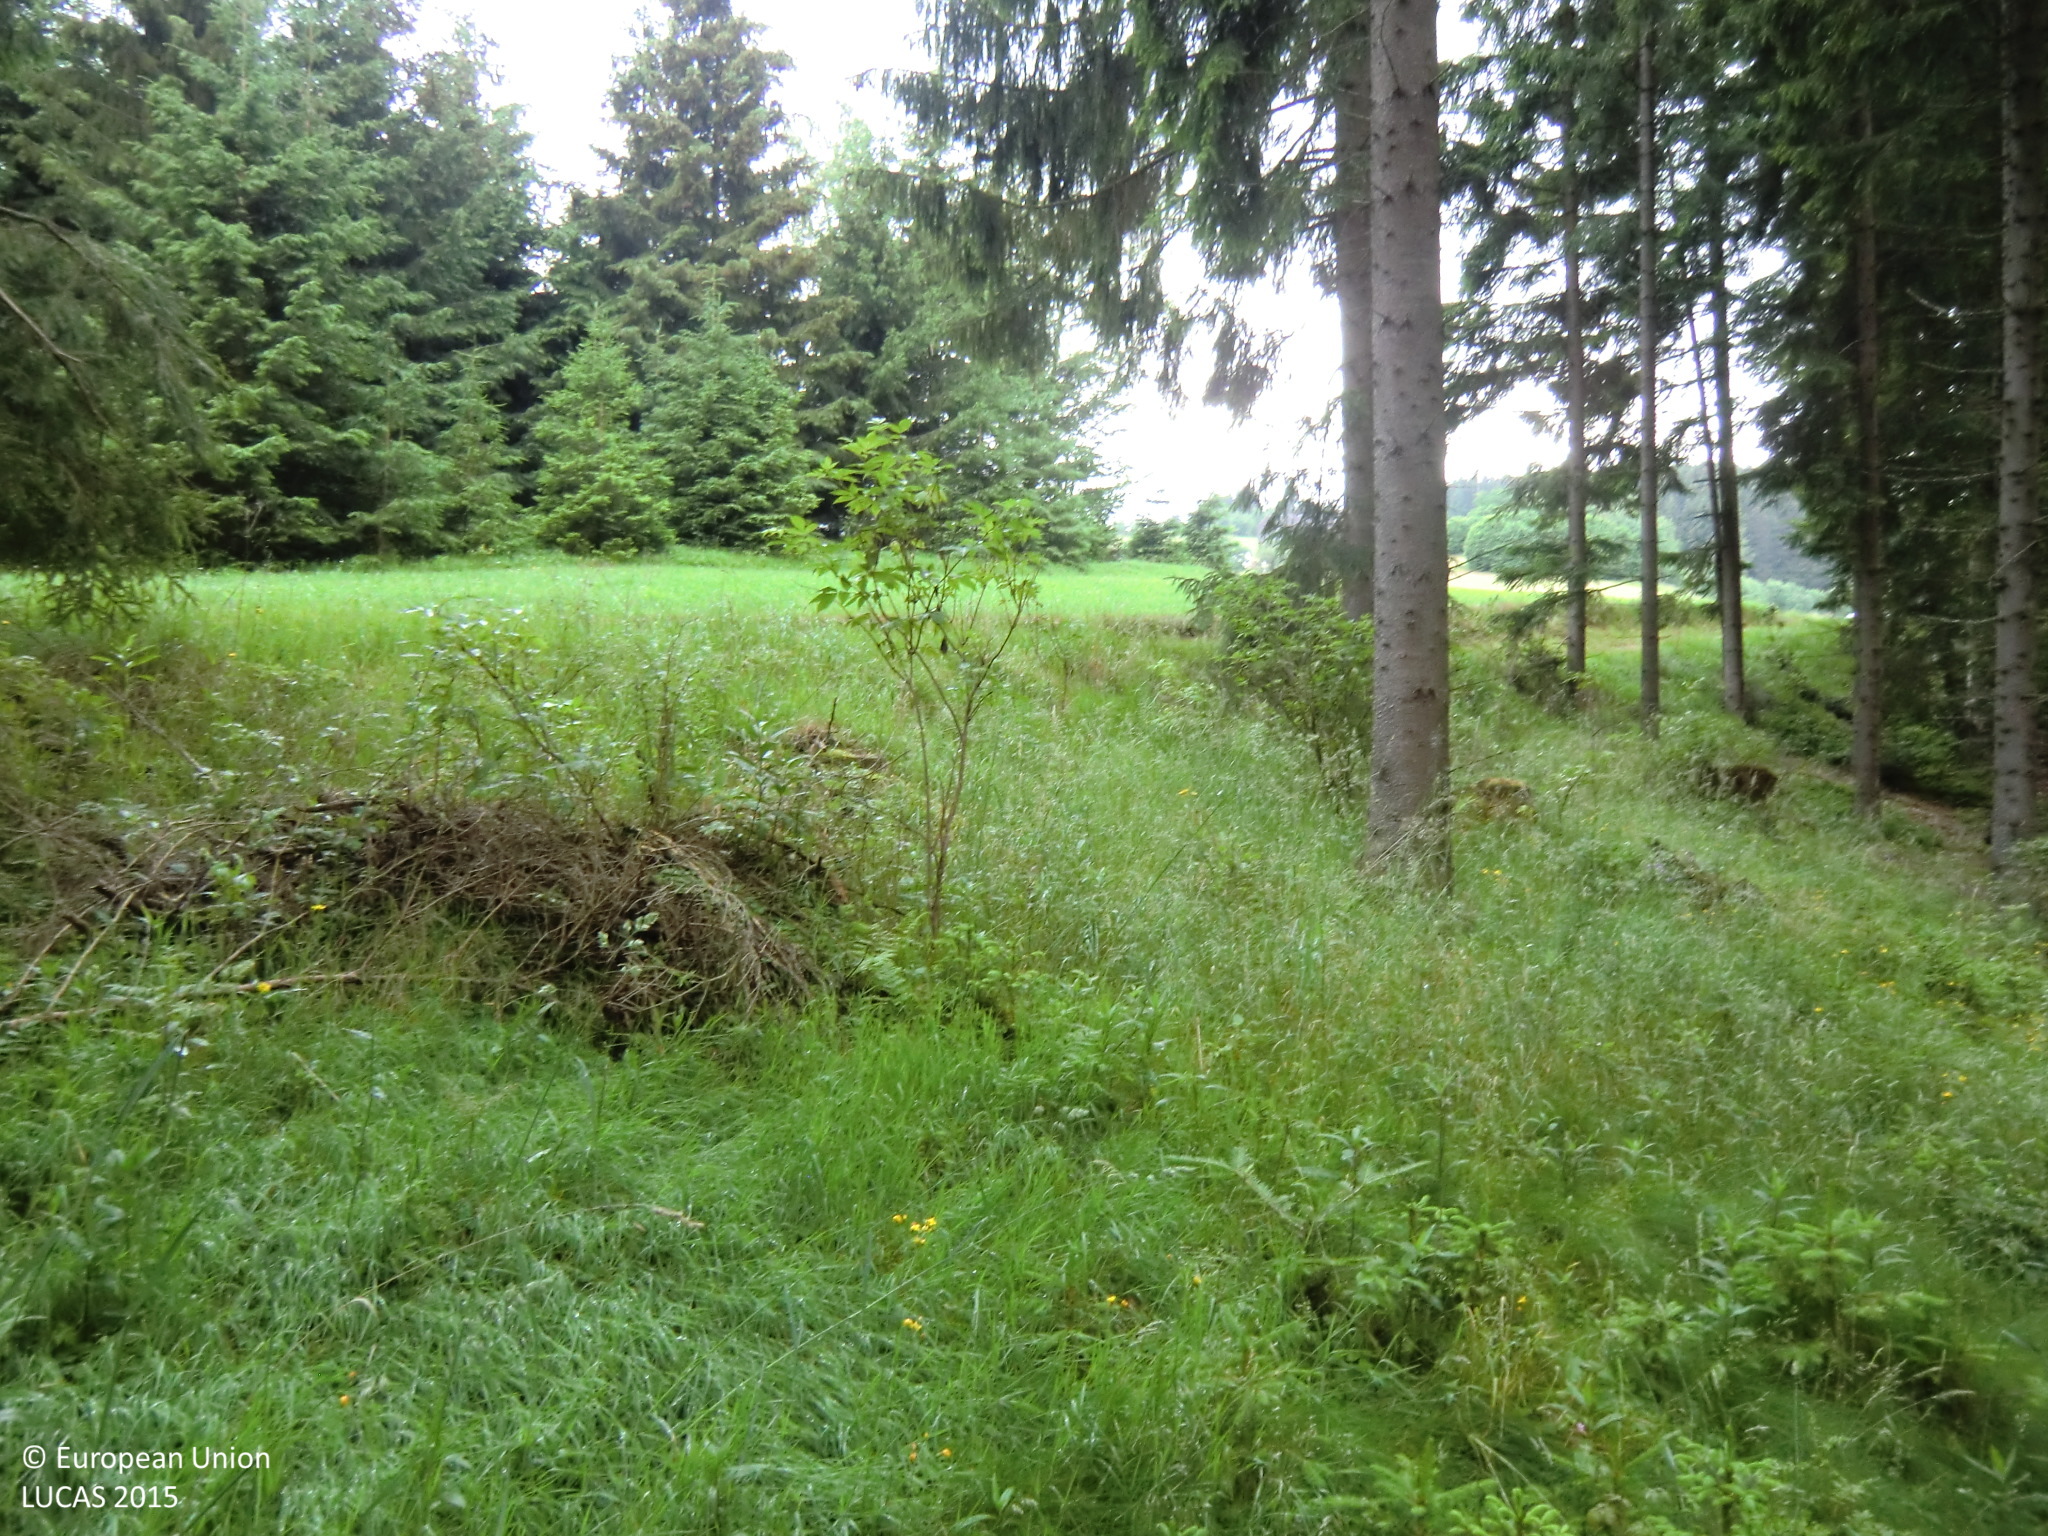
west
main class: Woodland
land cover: Spruce dominated coniferous woodland
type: hemiboreal forest and nemoral coniferous forest and mixed broadleaved-coniferous forest
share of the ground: > 75 %
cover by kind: coniferous forest trees 75 %, herbaceous plants 15 %, shrubs 10 %
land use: Forestry
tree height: > 5 m
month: June
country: AT
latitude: 48.4806
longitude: 14.7767
